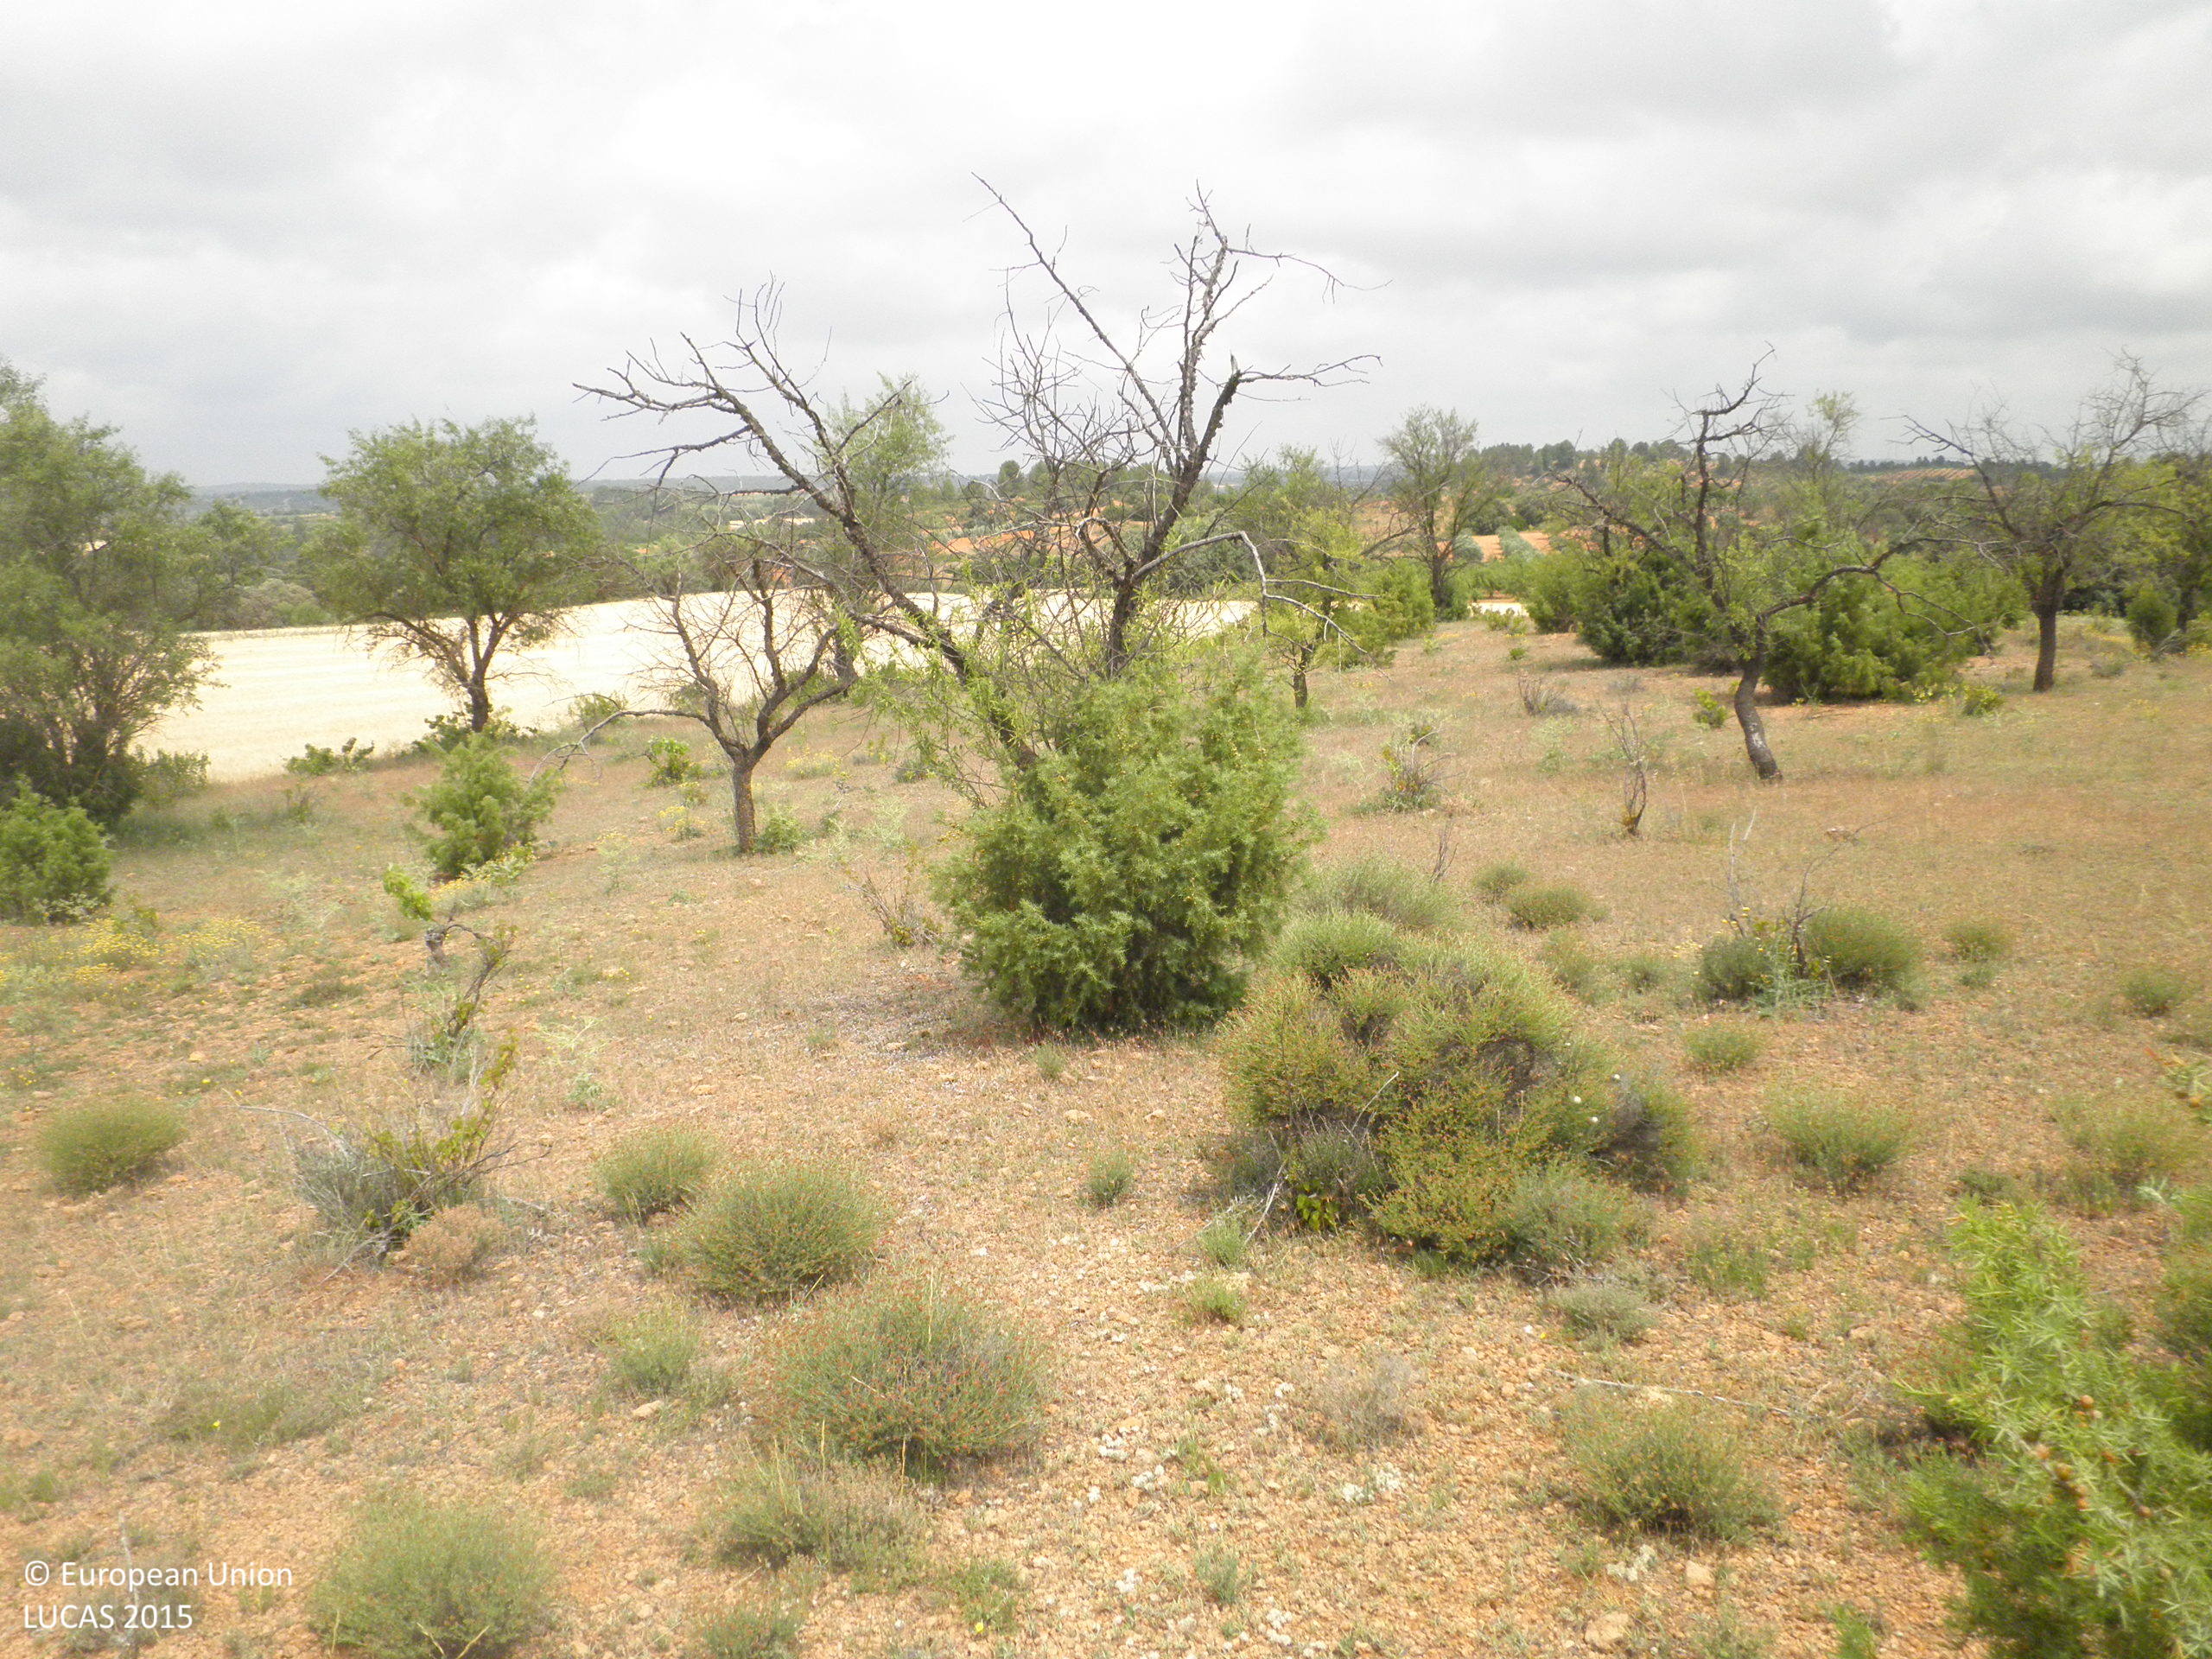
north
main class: Cropland
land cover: Nuts trees
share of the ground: < 10 %
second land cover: Grassland without tree/shrub cover
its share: 50 - 75 %
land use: Abandoned areas
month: June
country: ES
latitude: 39.5519
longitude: -1.6550
